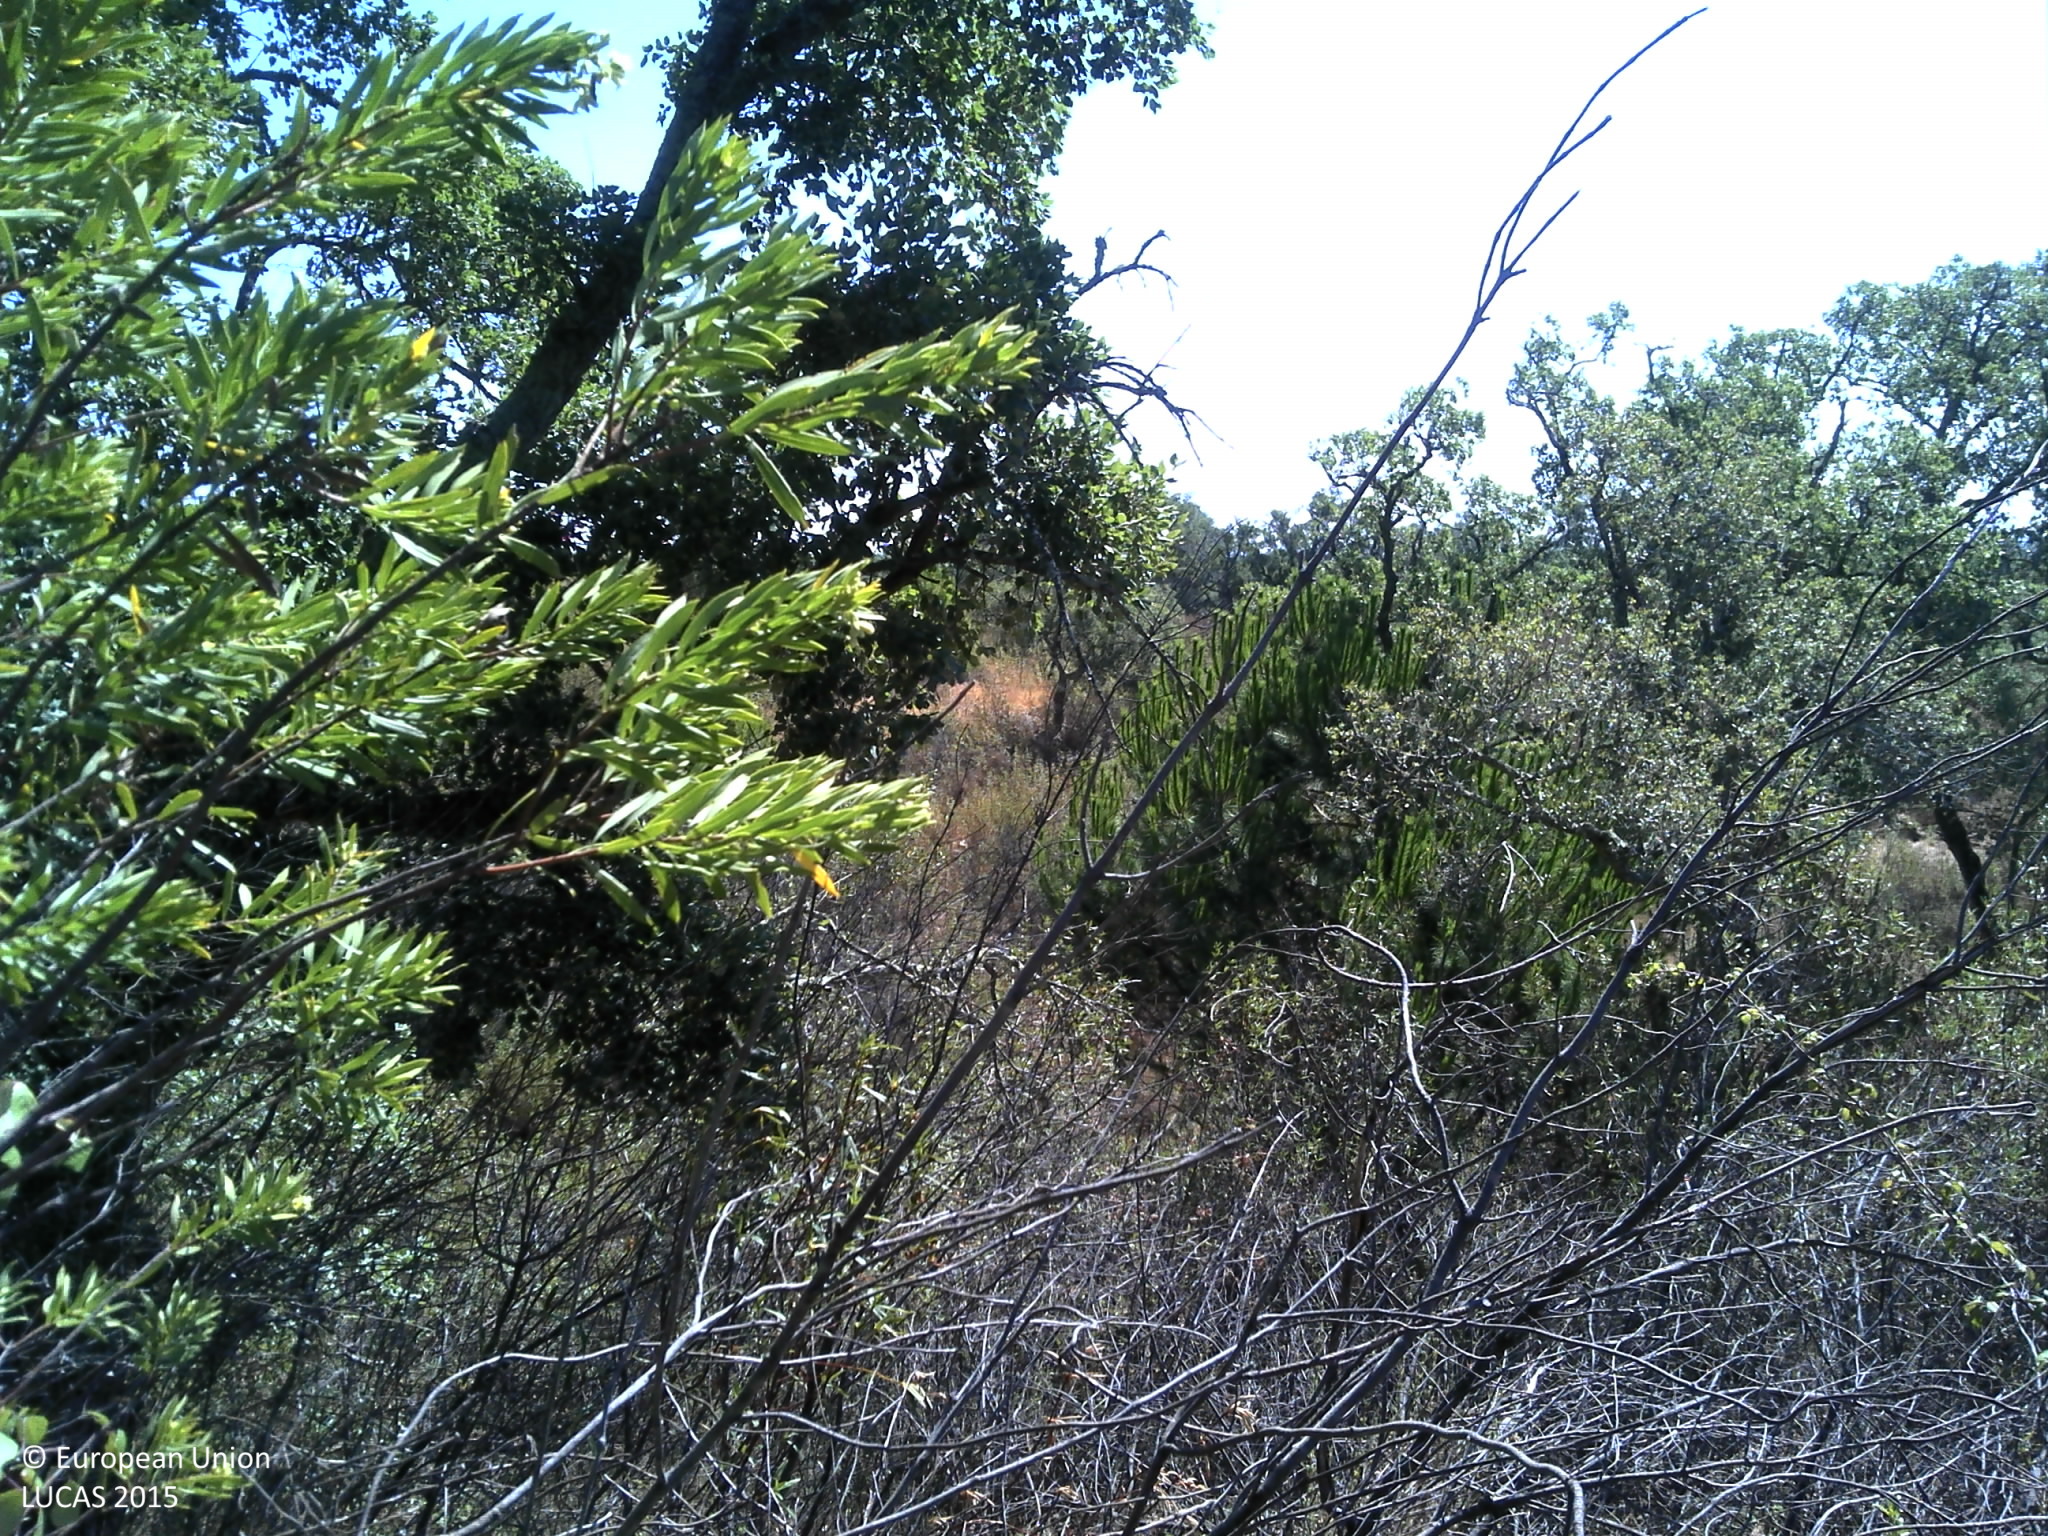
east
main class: Woodland
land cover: Pine dominated mixed woodland
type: coniferous forest of the mediterranean region
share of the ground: 10 - 25 %
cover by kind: shrubs 45 %, coniferous forest trees 25 %, unconsolidated bare surface 20 %, broadleaved forest trees 10 %
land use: Forestry
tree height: > 5 m
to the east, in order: Pine dominated mixed woodland; Broadleaved woodland
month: July
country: PT
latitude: 38.4862
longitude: -8.5222
